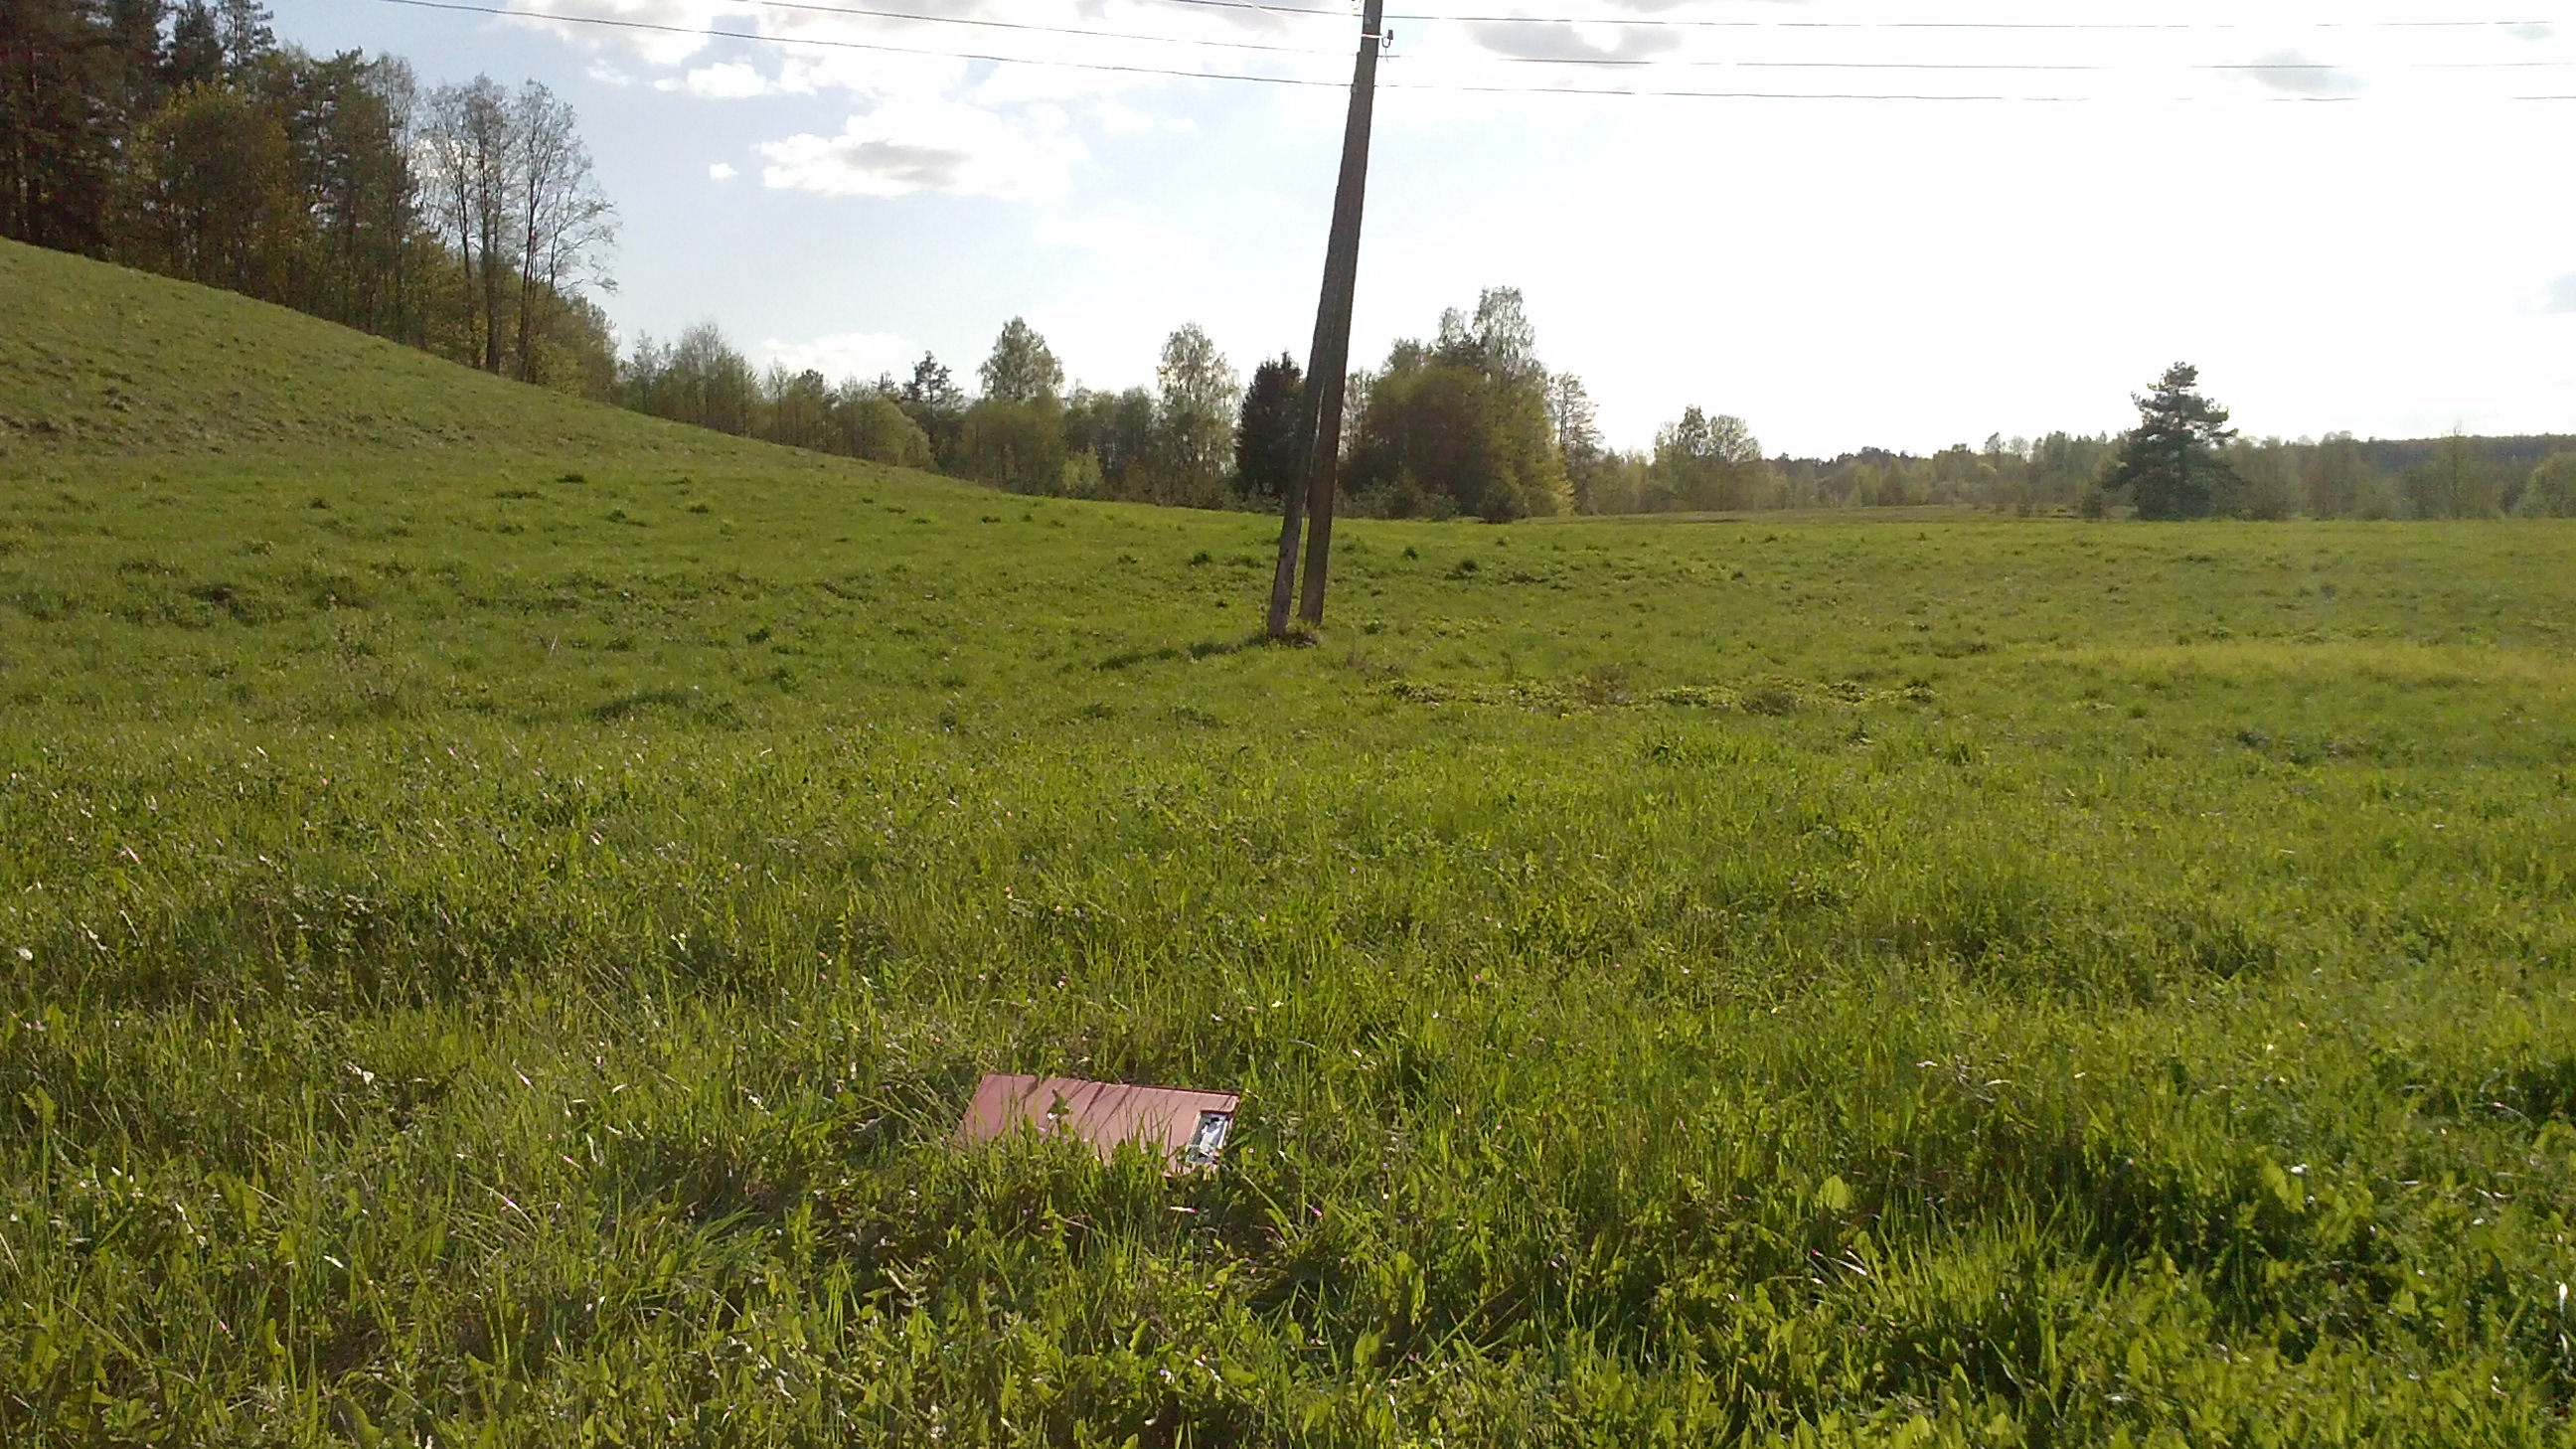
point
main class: Grassland
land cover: Grassland without tree/shrub cover
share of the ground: > 75 %
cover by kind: herbaceous plants 100 %
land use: Agriculture (excluding fallow land and kitchen gardens)
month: May
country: LV
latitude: 56.0579
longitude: 27.2434
